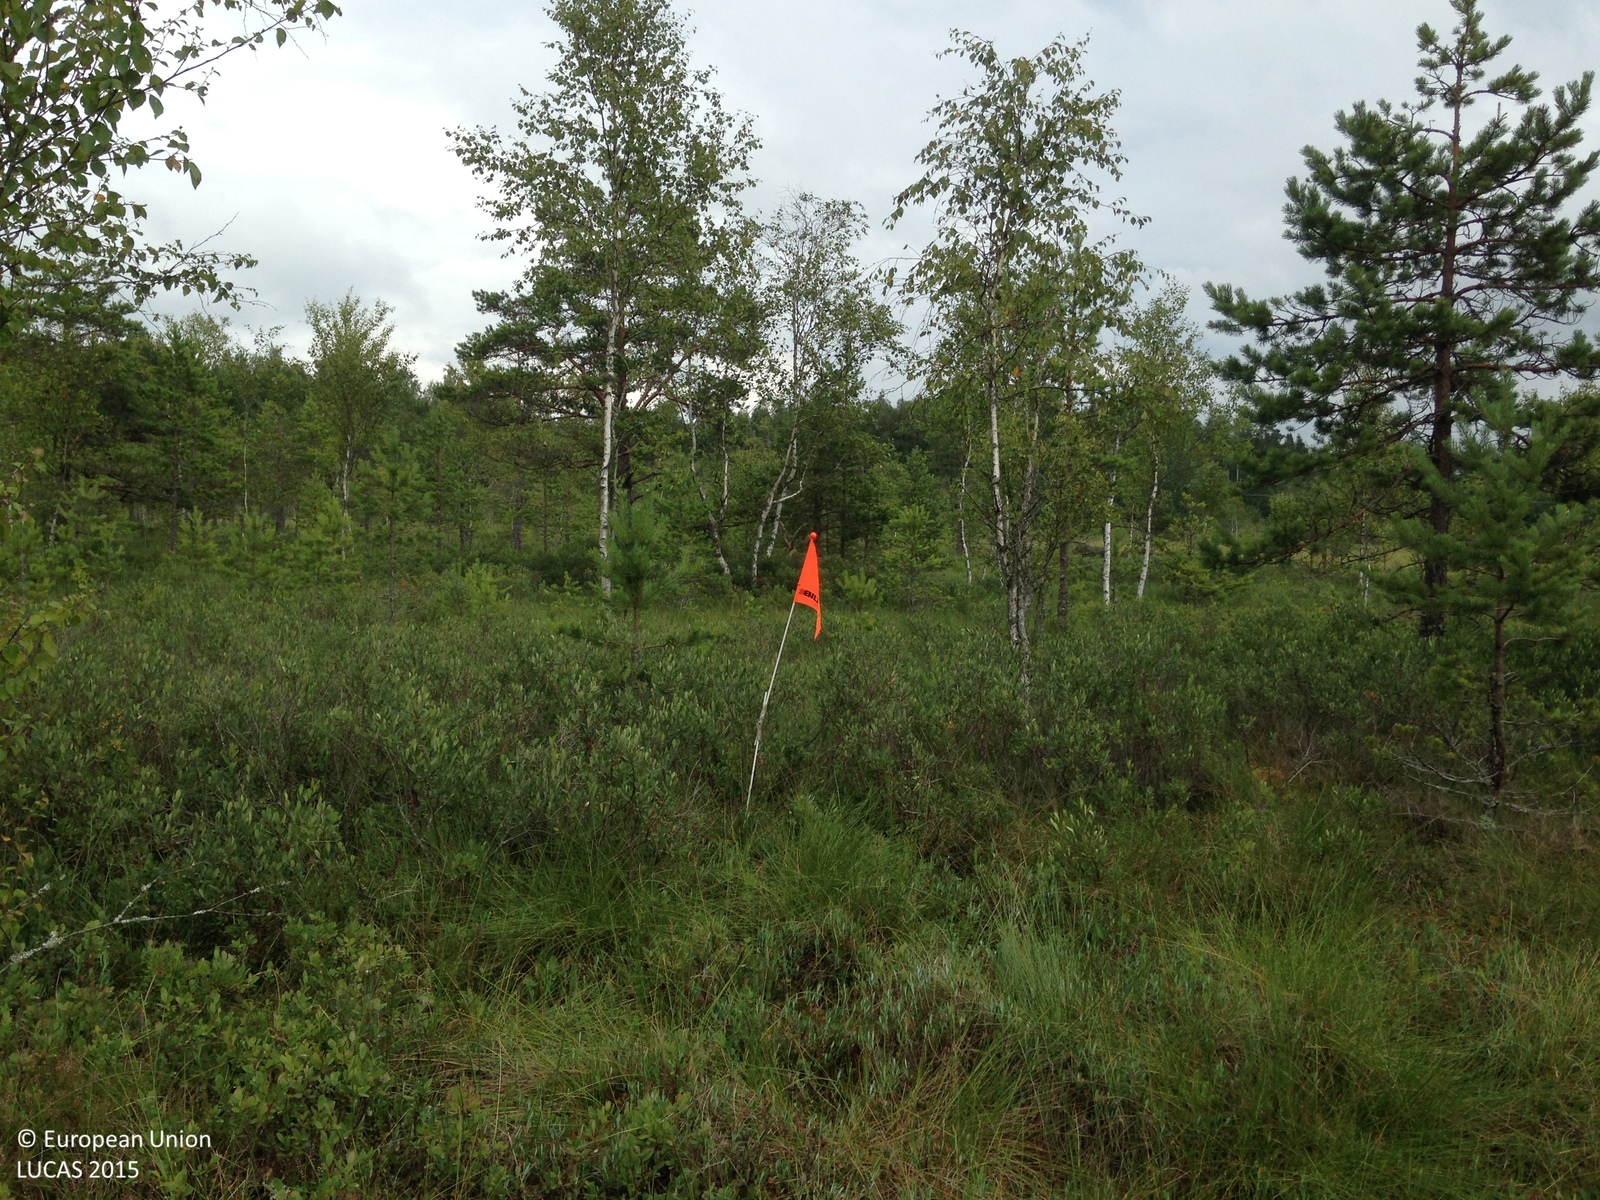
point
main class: Woodland
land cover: Pine dominated mixed woodland
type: boreal forest
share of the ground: 25 - 50 %
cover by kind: lichens and mosses 30 %, shrubs 25 %, coniferous forest trees 20 %, broadleaved forest trees 15 %, herbaceous plants 10 %
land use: Semi-natural and natural areas not in use
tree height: < 5 m
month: July
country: SE
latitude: 59.0584
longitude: 14.6478
